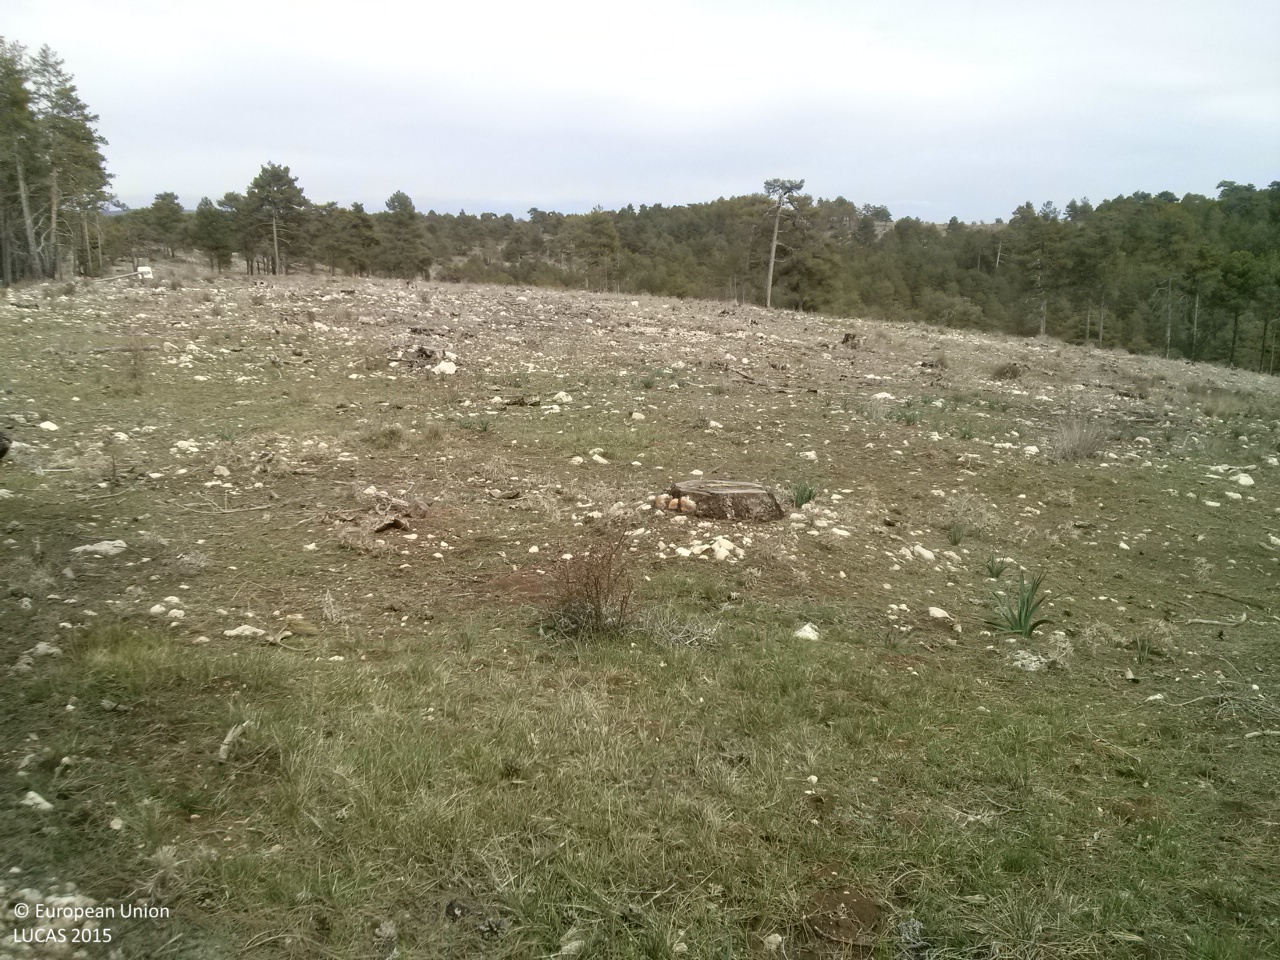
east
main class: Woodland
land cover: Pine dominated coniferous woodland
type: coniferous forest of the mediterranean region
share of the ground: 10 - 25 %
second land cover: Grassland without tree/shrub cover
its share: > 75 %
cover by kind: herbaceous plants 80 %, coniferous forest trees 20 %
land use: Forestry
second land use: Agriculture (excluding fallow land and kitchen gardens)
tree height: > 5 m
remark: Burnt area
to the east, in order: Pine dominated coniferous woodland; Grassland without tree/shrub cover; Grassland with sparse tree/shrub cover; Grassland without tree/shrub cover; Pine dominated coniferous woodland
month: April
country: ES
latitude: 40.2854
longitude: -1.9317
